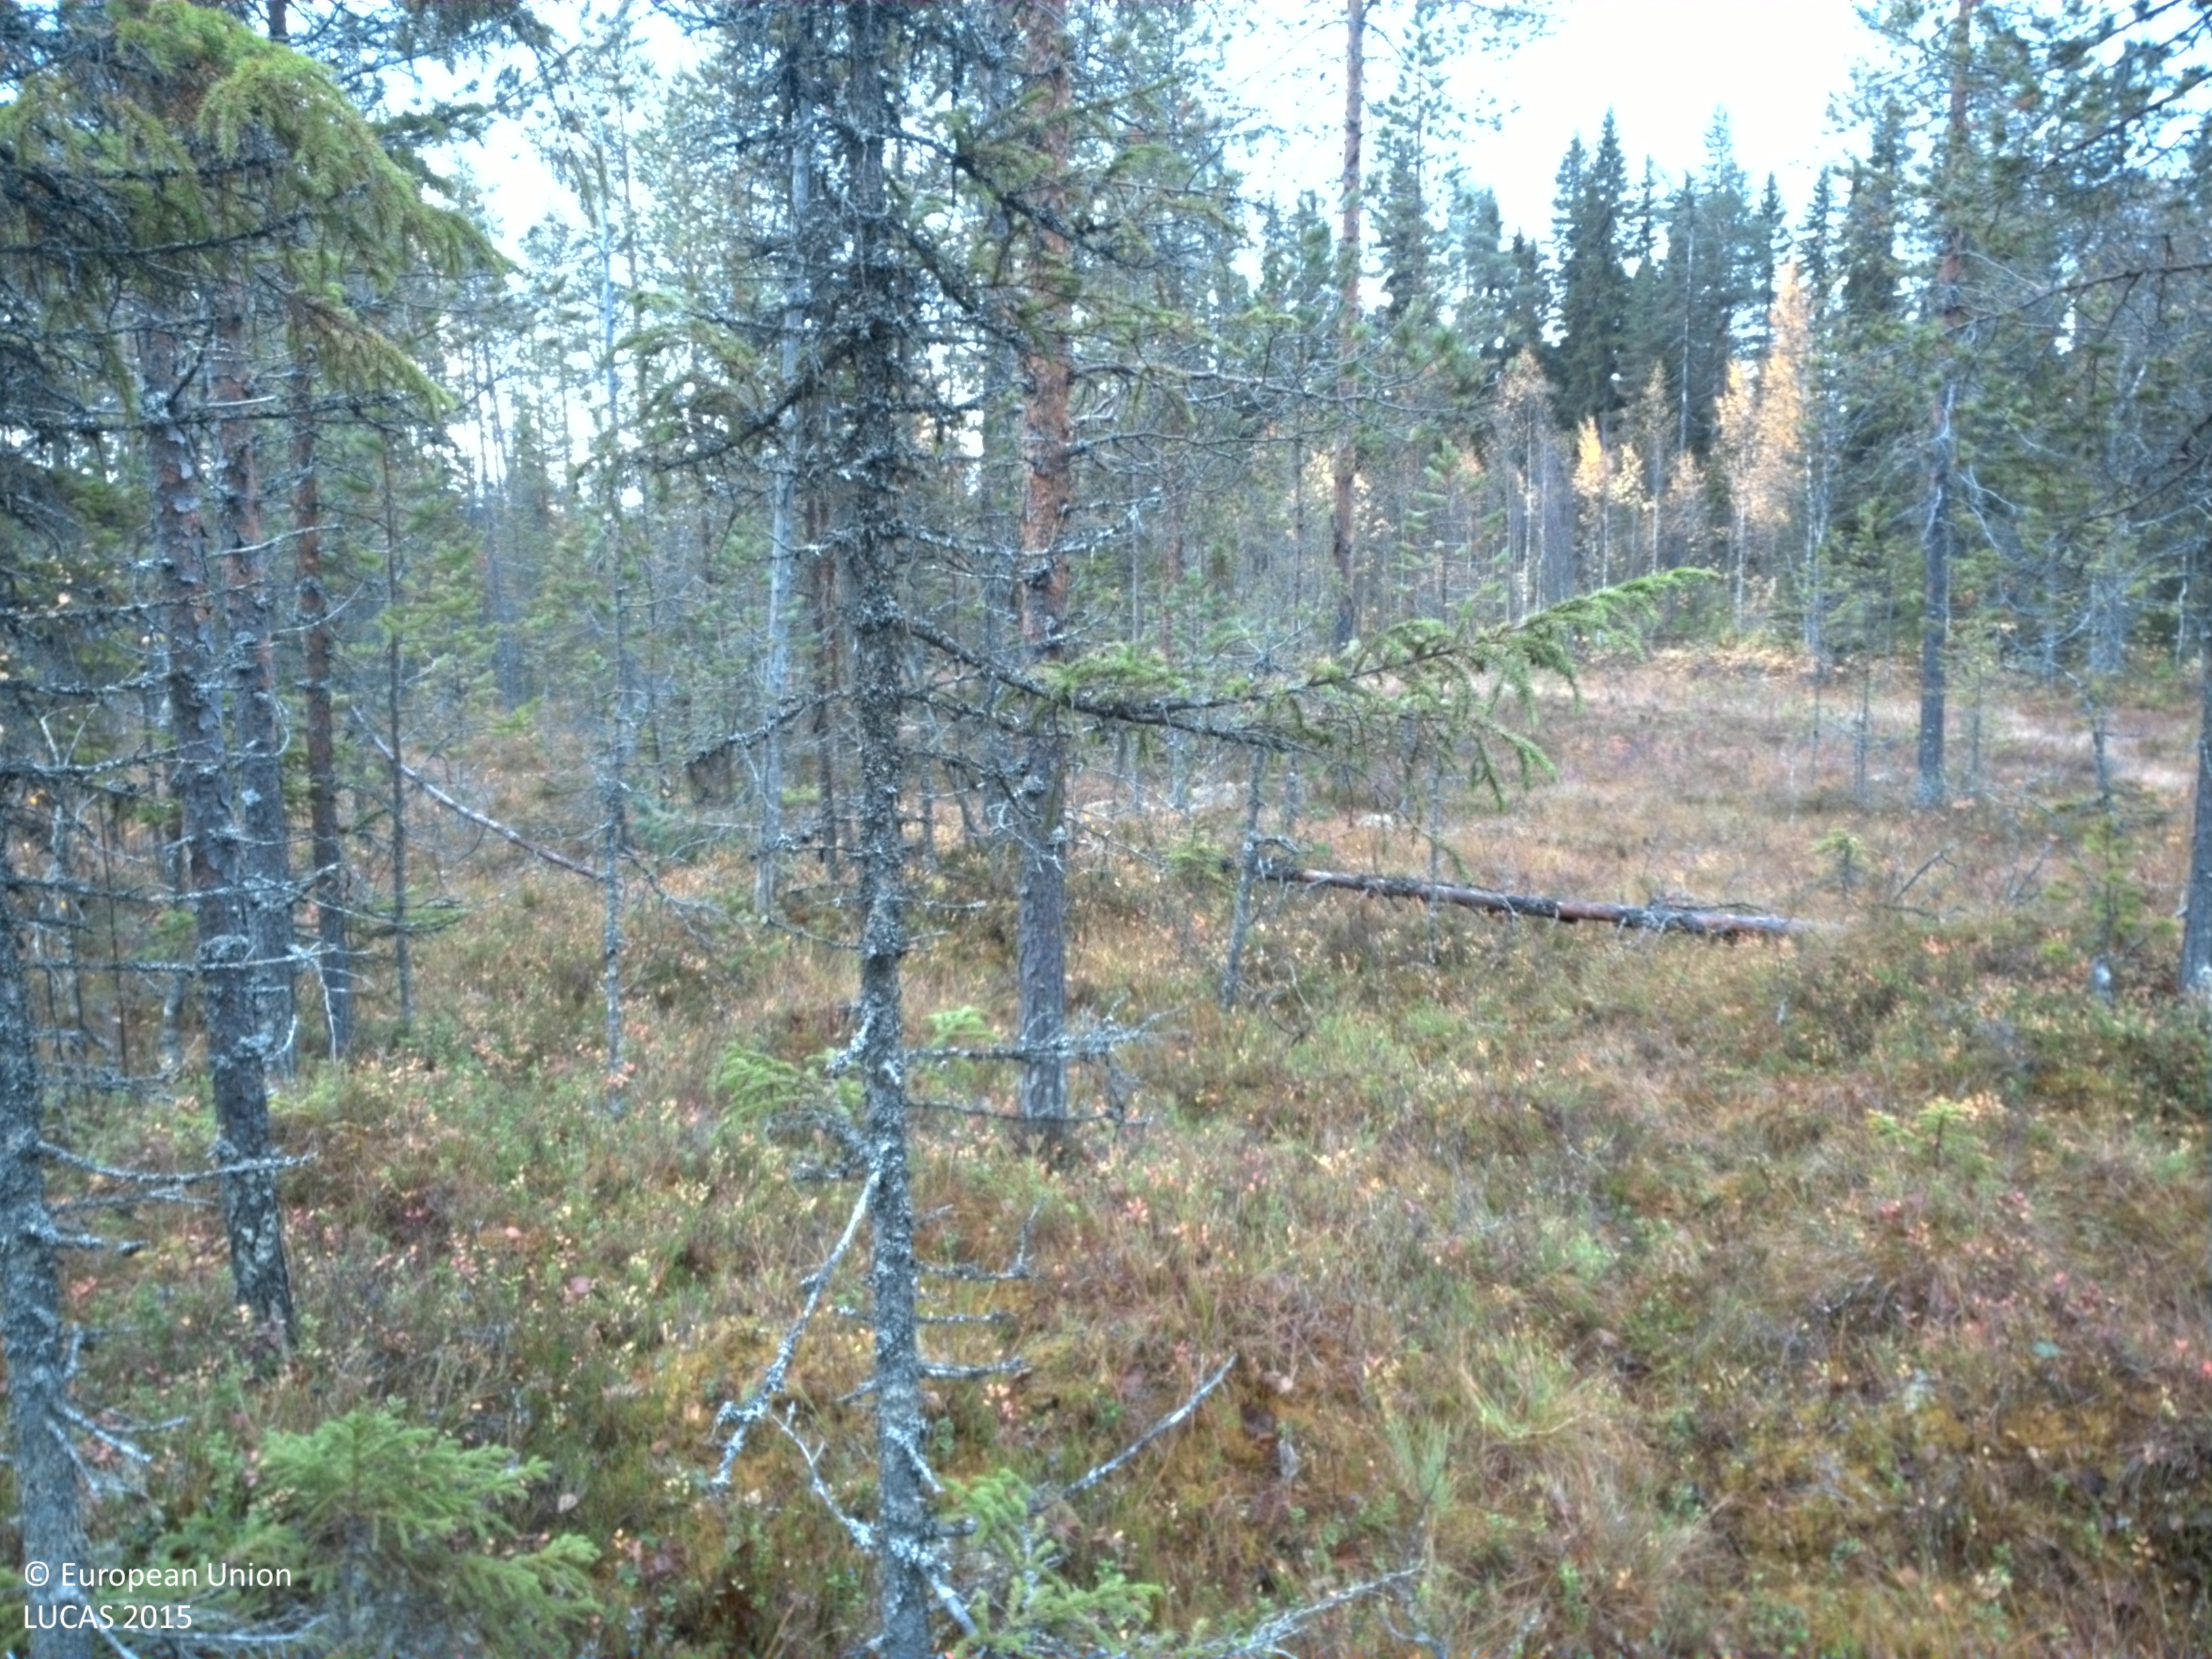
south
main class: Woodland
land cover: Pine dominated coniferous woodland
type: boreal forest
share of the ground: 25 - 50 %
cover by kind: coniferous forest trees 30 %, shrubs 25 %, lichens and mosses 25 %, herbaceous plants 15 %, broadleaved forest trees 5 %
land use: Forestry
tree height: > 5 m
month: October
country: SE
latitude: 64.9640
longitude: 17.5244
